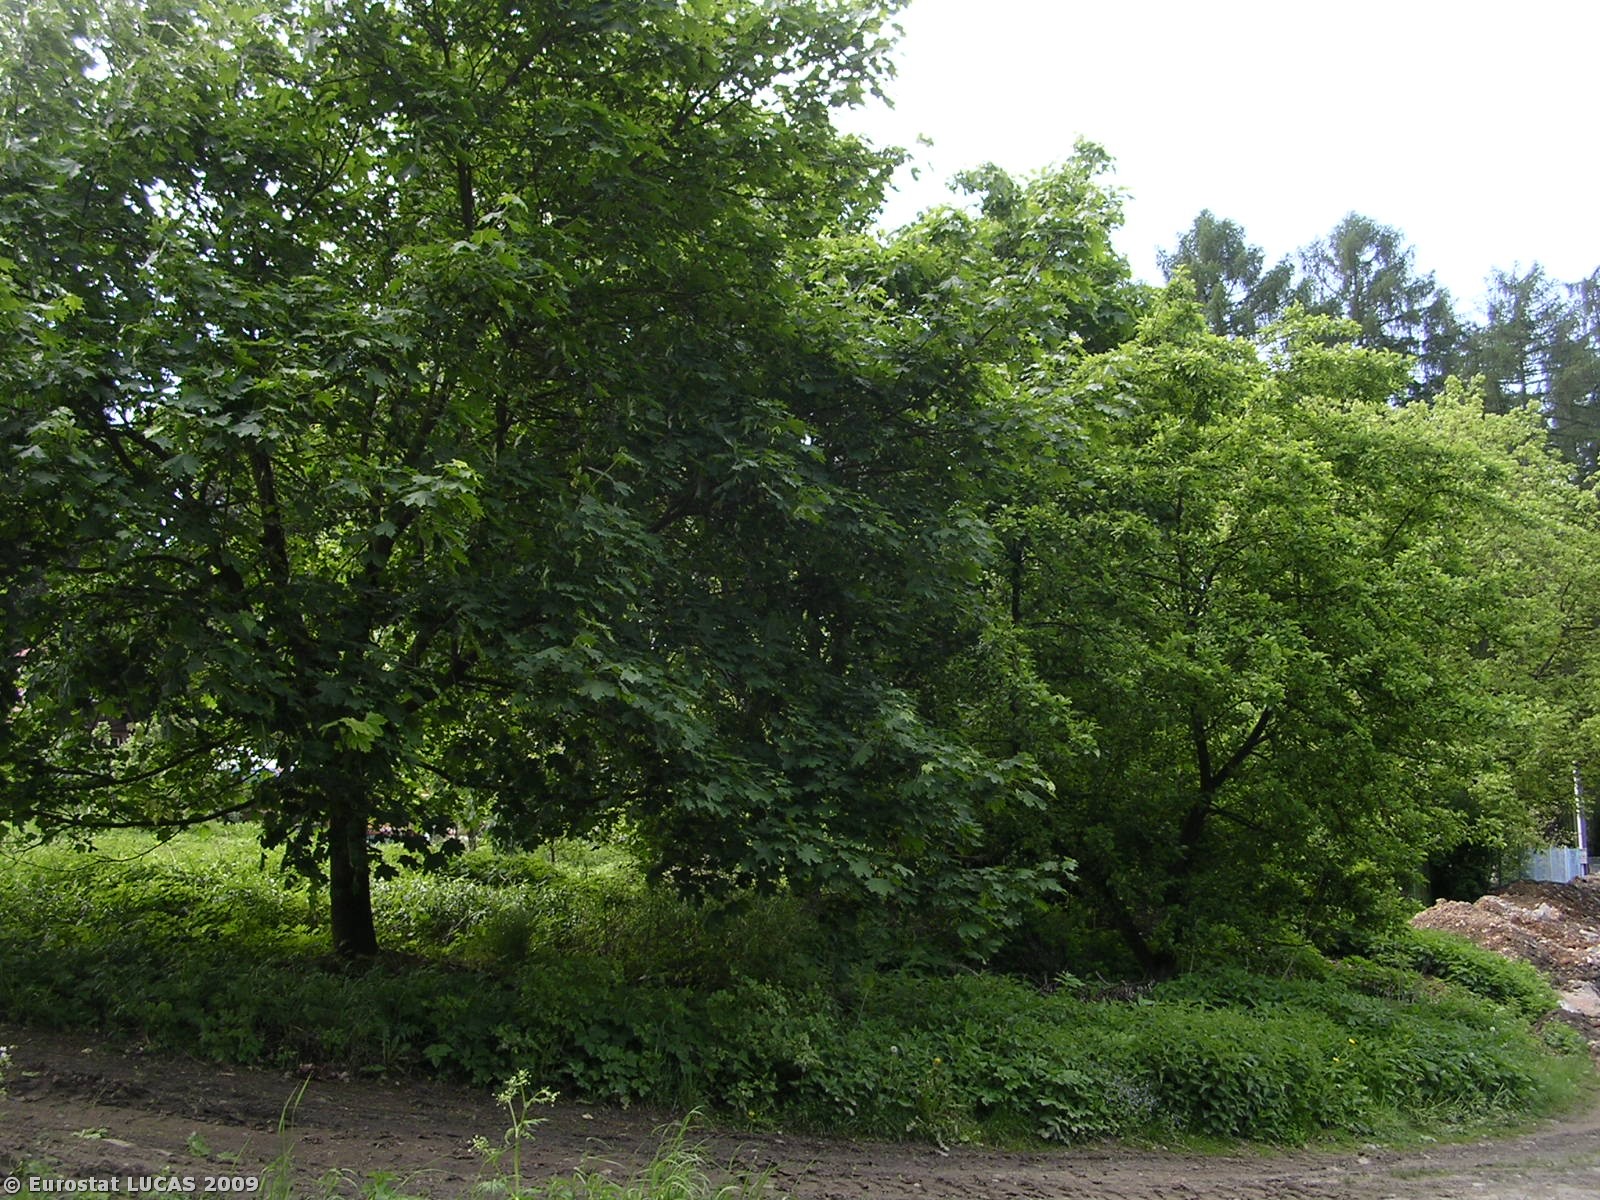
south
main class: Grassland
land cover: Grassland without tree/shrub cover
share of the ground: > 75 %
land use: Water supply and treatment
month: May
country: CZ
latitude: 49.9277
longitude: 14.6407
